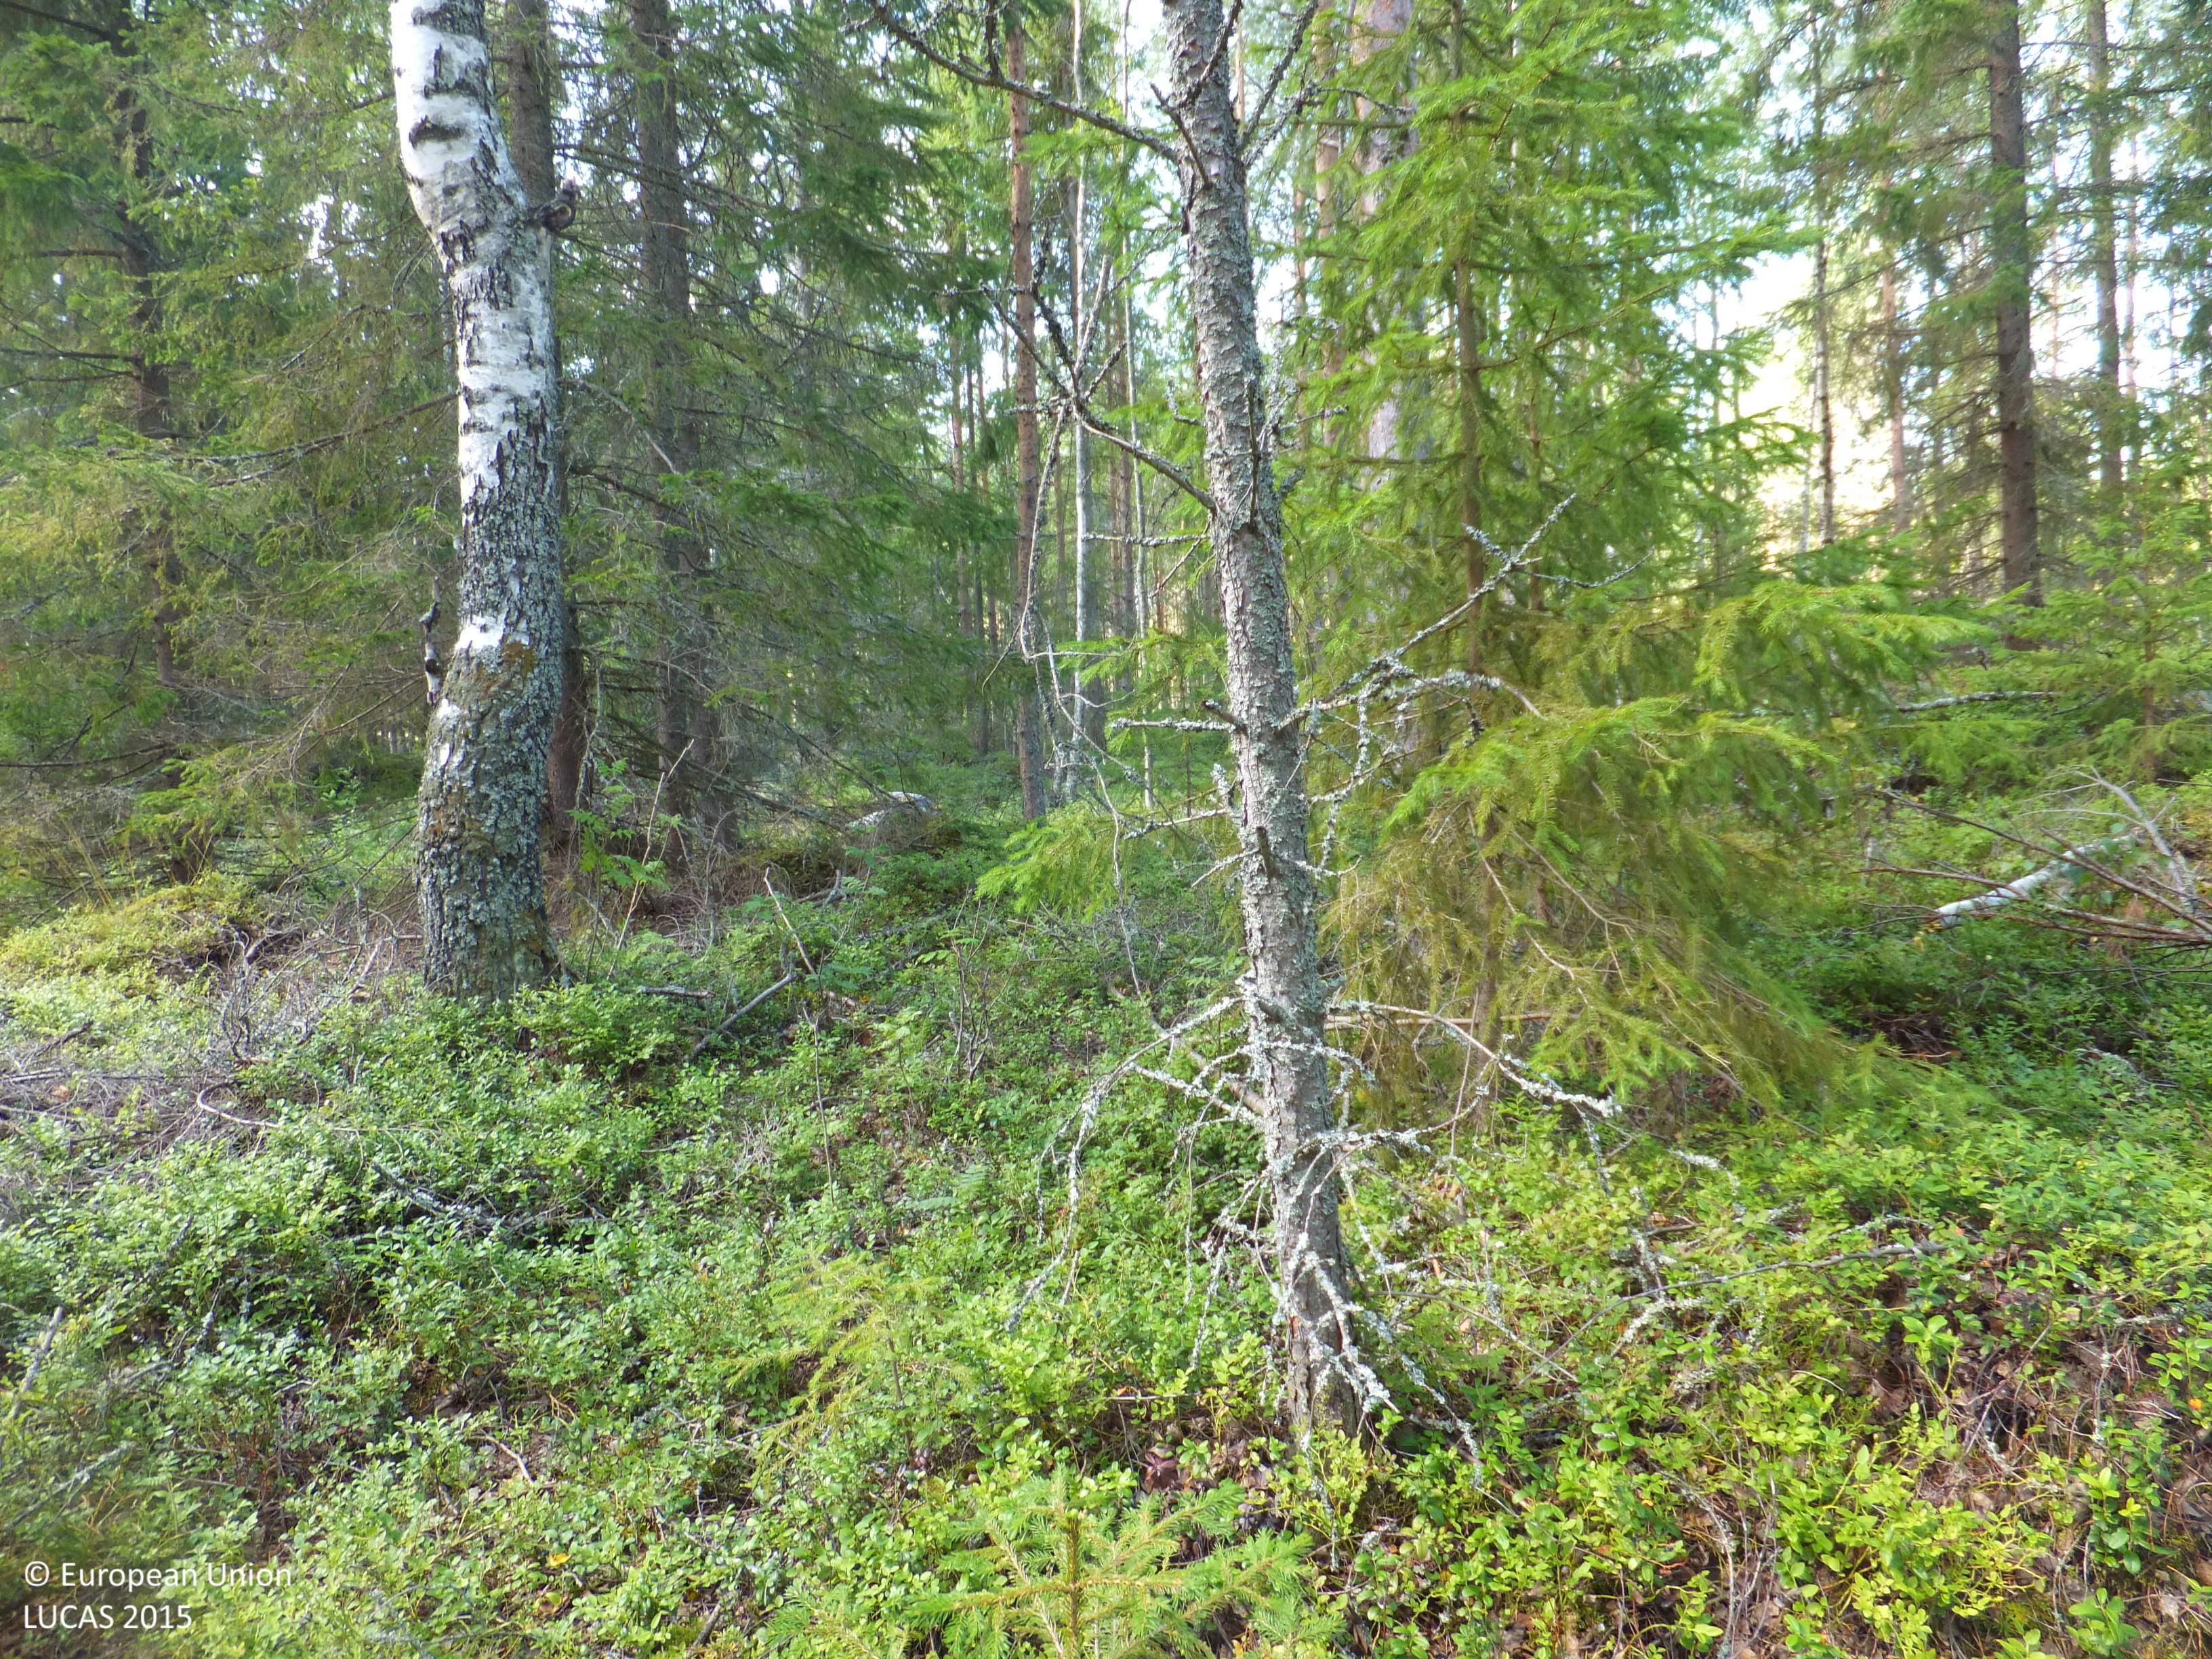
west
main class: Woodland
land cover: Other mixed woodland
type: boreal forest
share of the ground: 50 - 75 %
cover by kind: coniferous forest trees 30 %, broadleaved forest trees 30 %, shrubs 20 %, lichens and mosses 10 %, herbaceous plants 5 %, consolidated bare surface 5 %
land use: Forestry
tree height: > 5 m
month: July
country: FI
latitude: 63.3514
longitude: 22.0534
